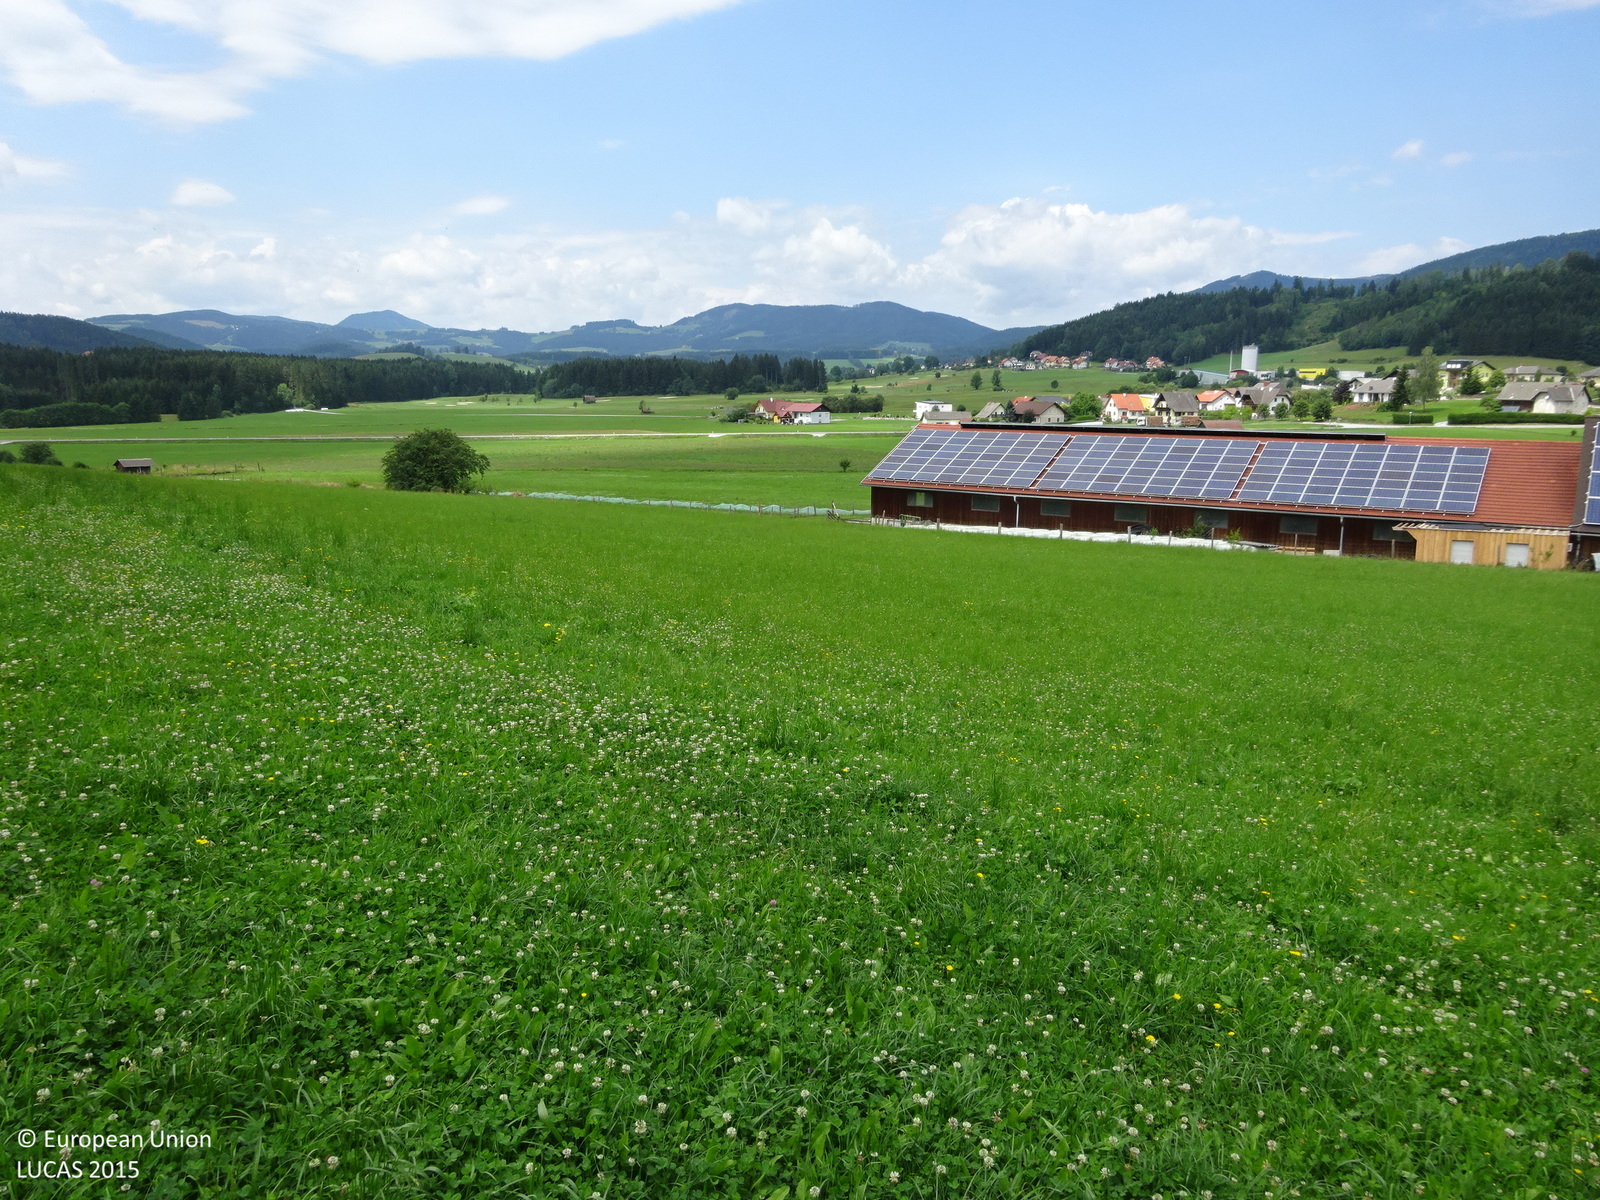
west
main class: Grassland
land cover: Grassland without tree/shrub cover
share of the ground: > 75 %
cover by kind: herbaceous plants 100 %
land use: Agriculture (excluding fallow land and kitchen gardens)
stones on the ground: < 10 %
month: July
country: AT
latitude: 47.2739
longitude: 15.5127
